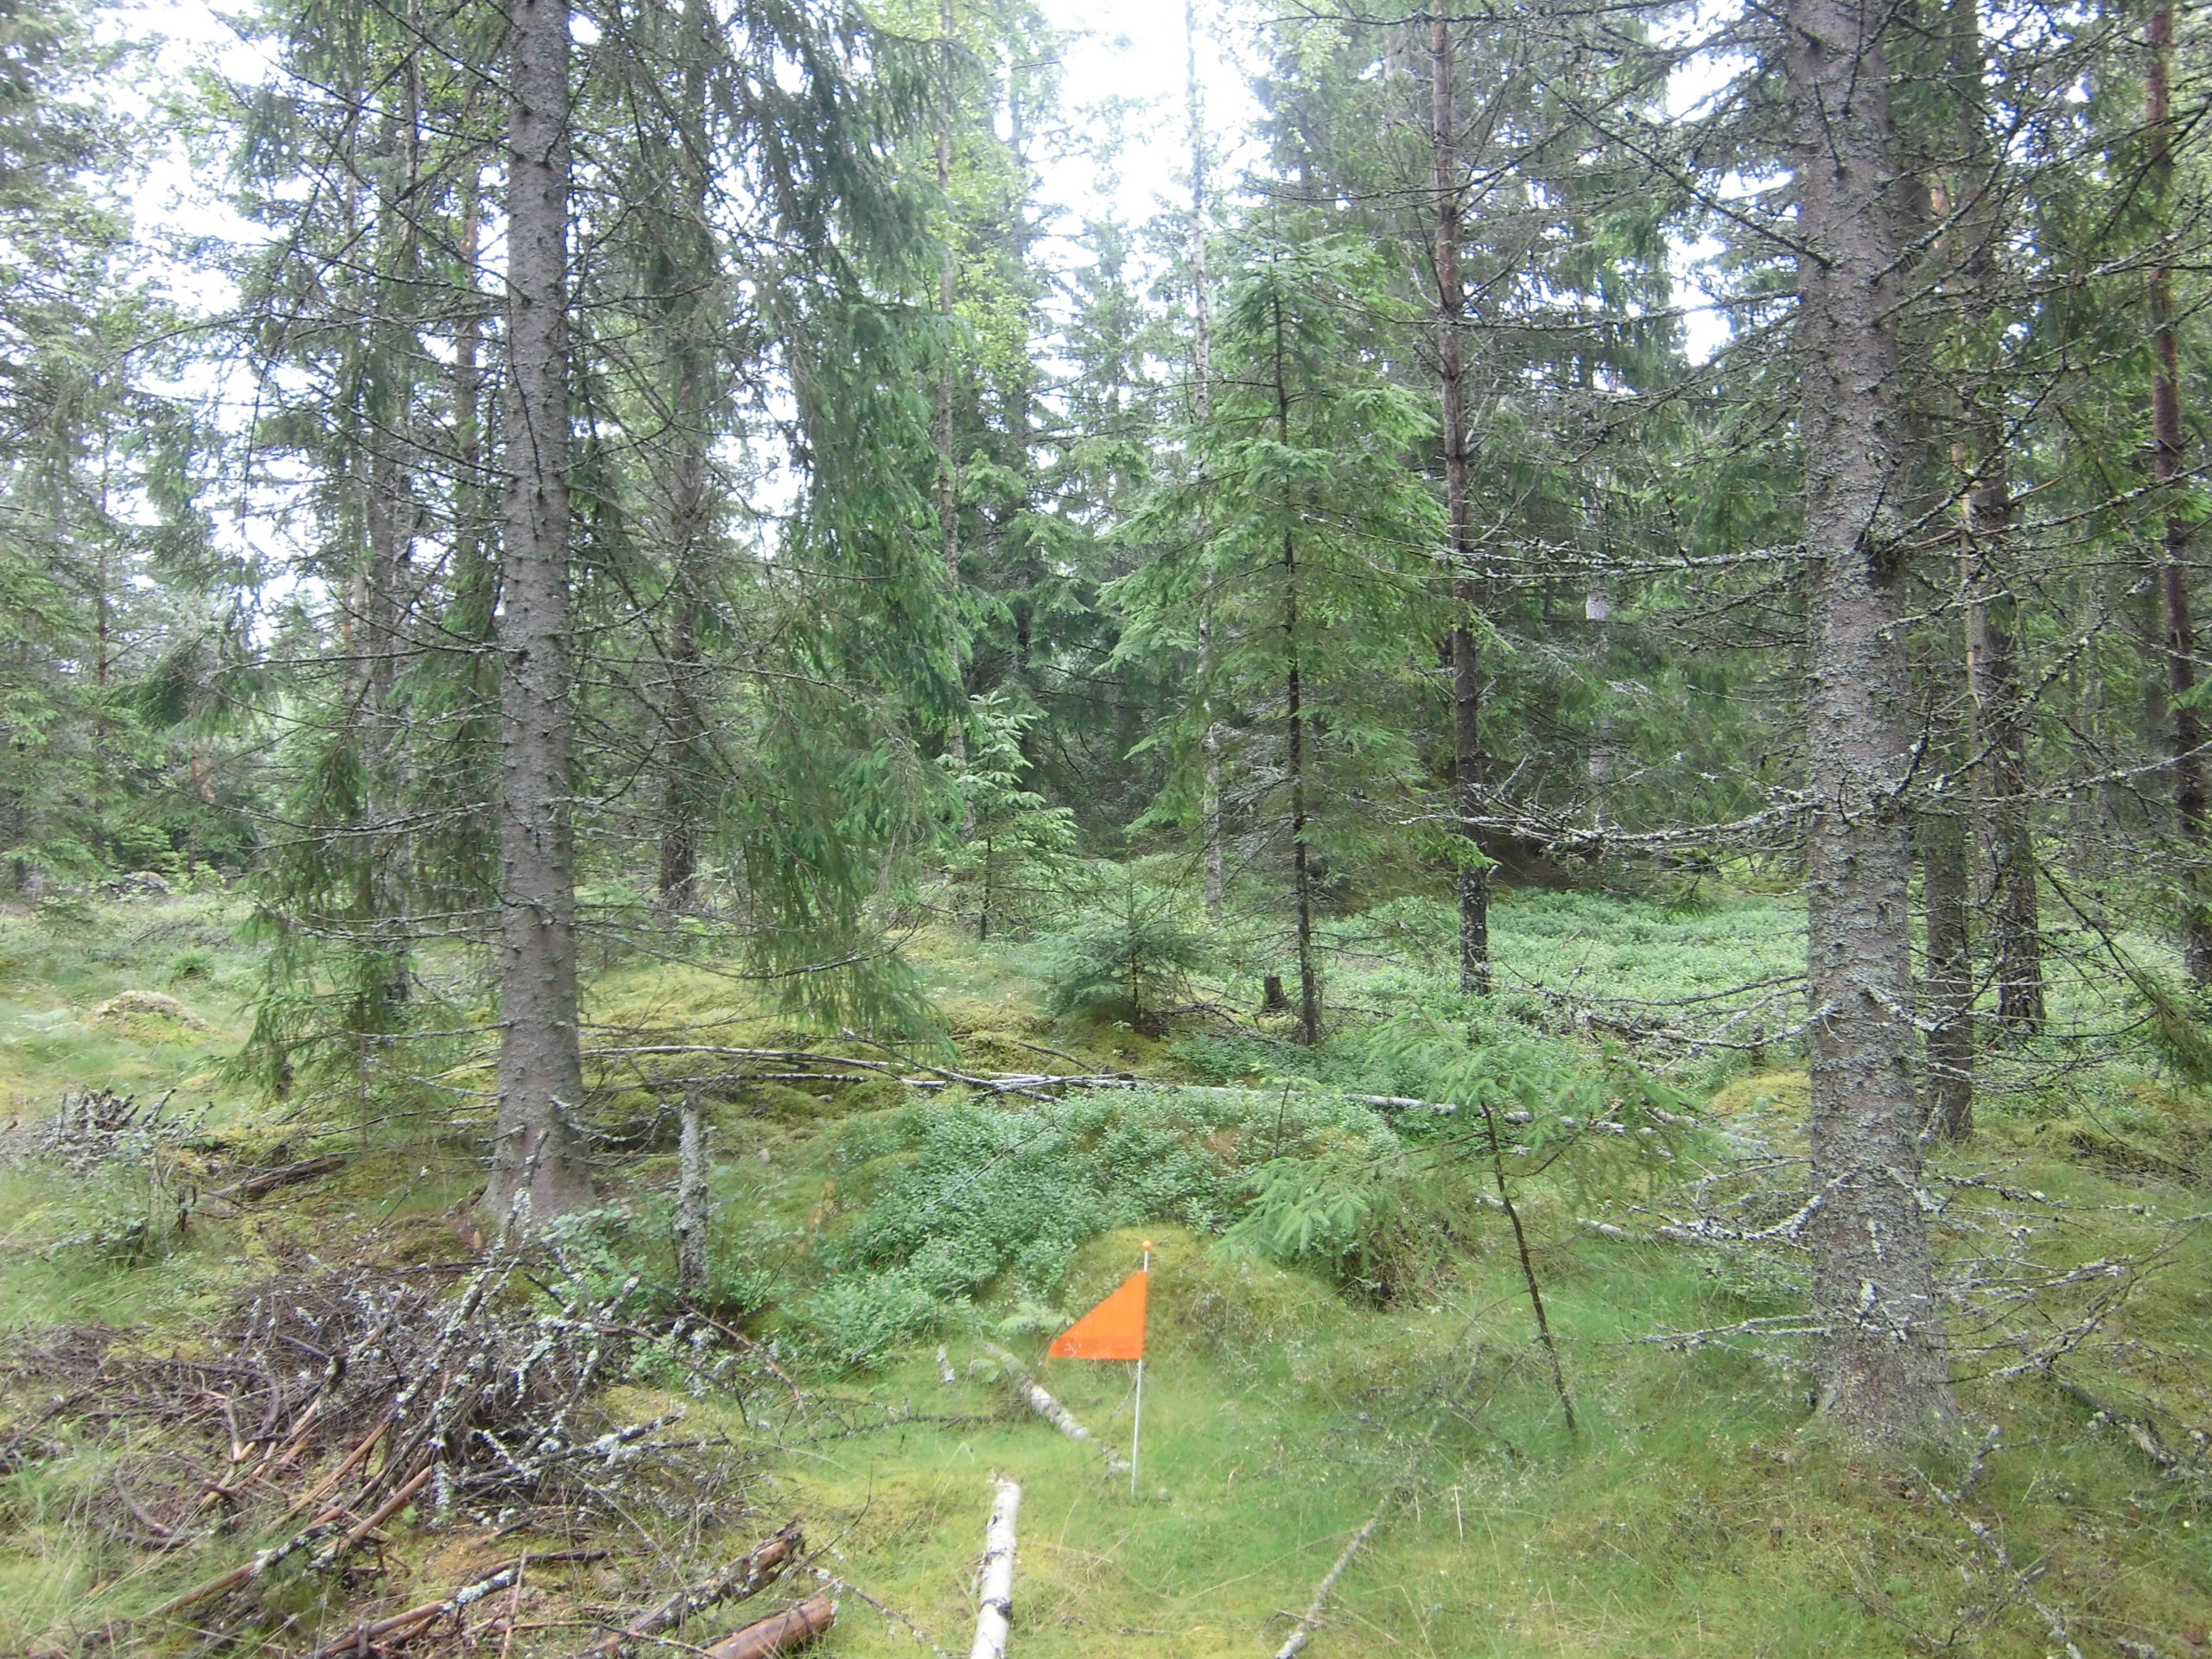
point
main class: Woodland
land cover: Spruce dominated coniferous woodland
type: boreal forest
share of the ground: 50 - 75 %
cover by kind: coniferous forest trees 55 %, lichens and mosses 20 %, herbaceous plants 15 %, broadleaved forest trees 5 %, shrubs 5 %
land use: Forestry
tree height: > 5 m
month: July
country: SE
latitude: 57.1402
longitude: 15.3349
